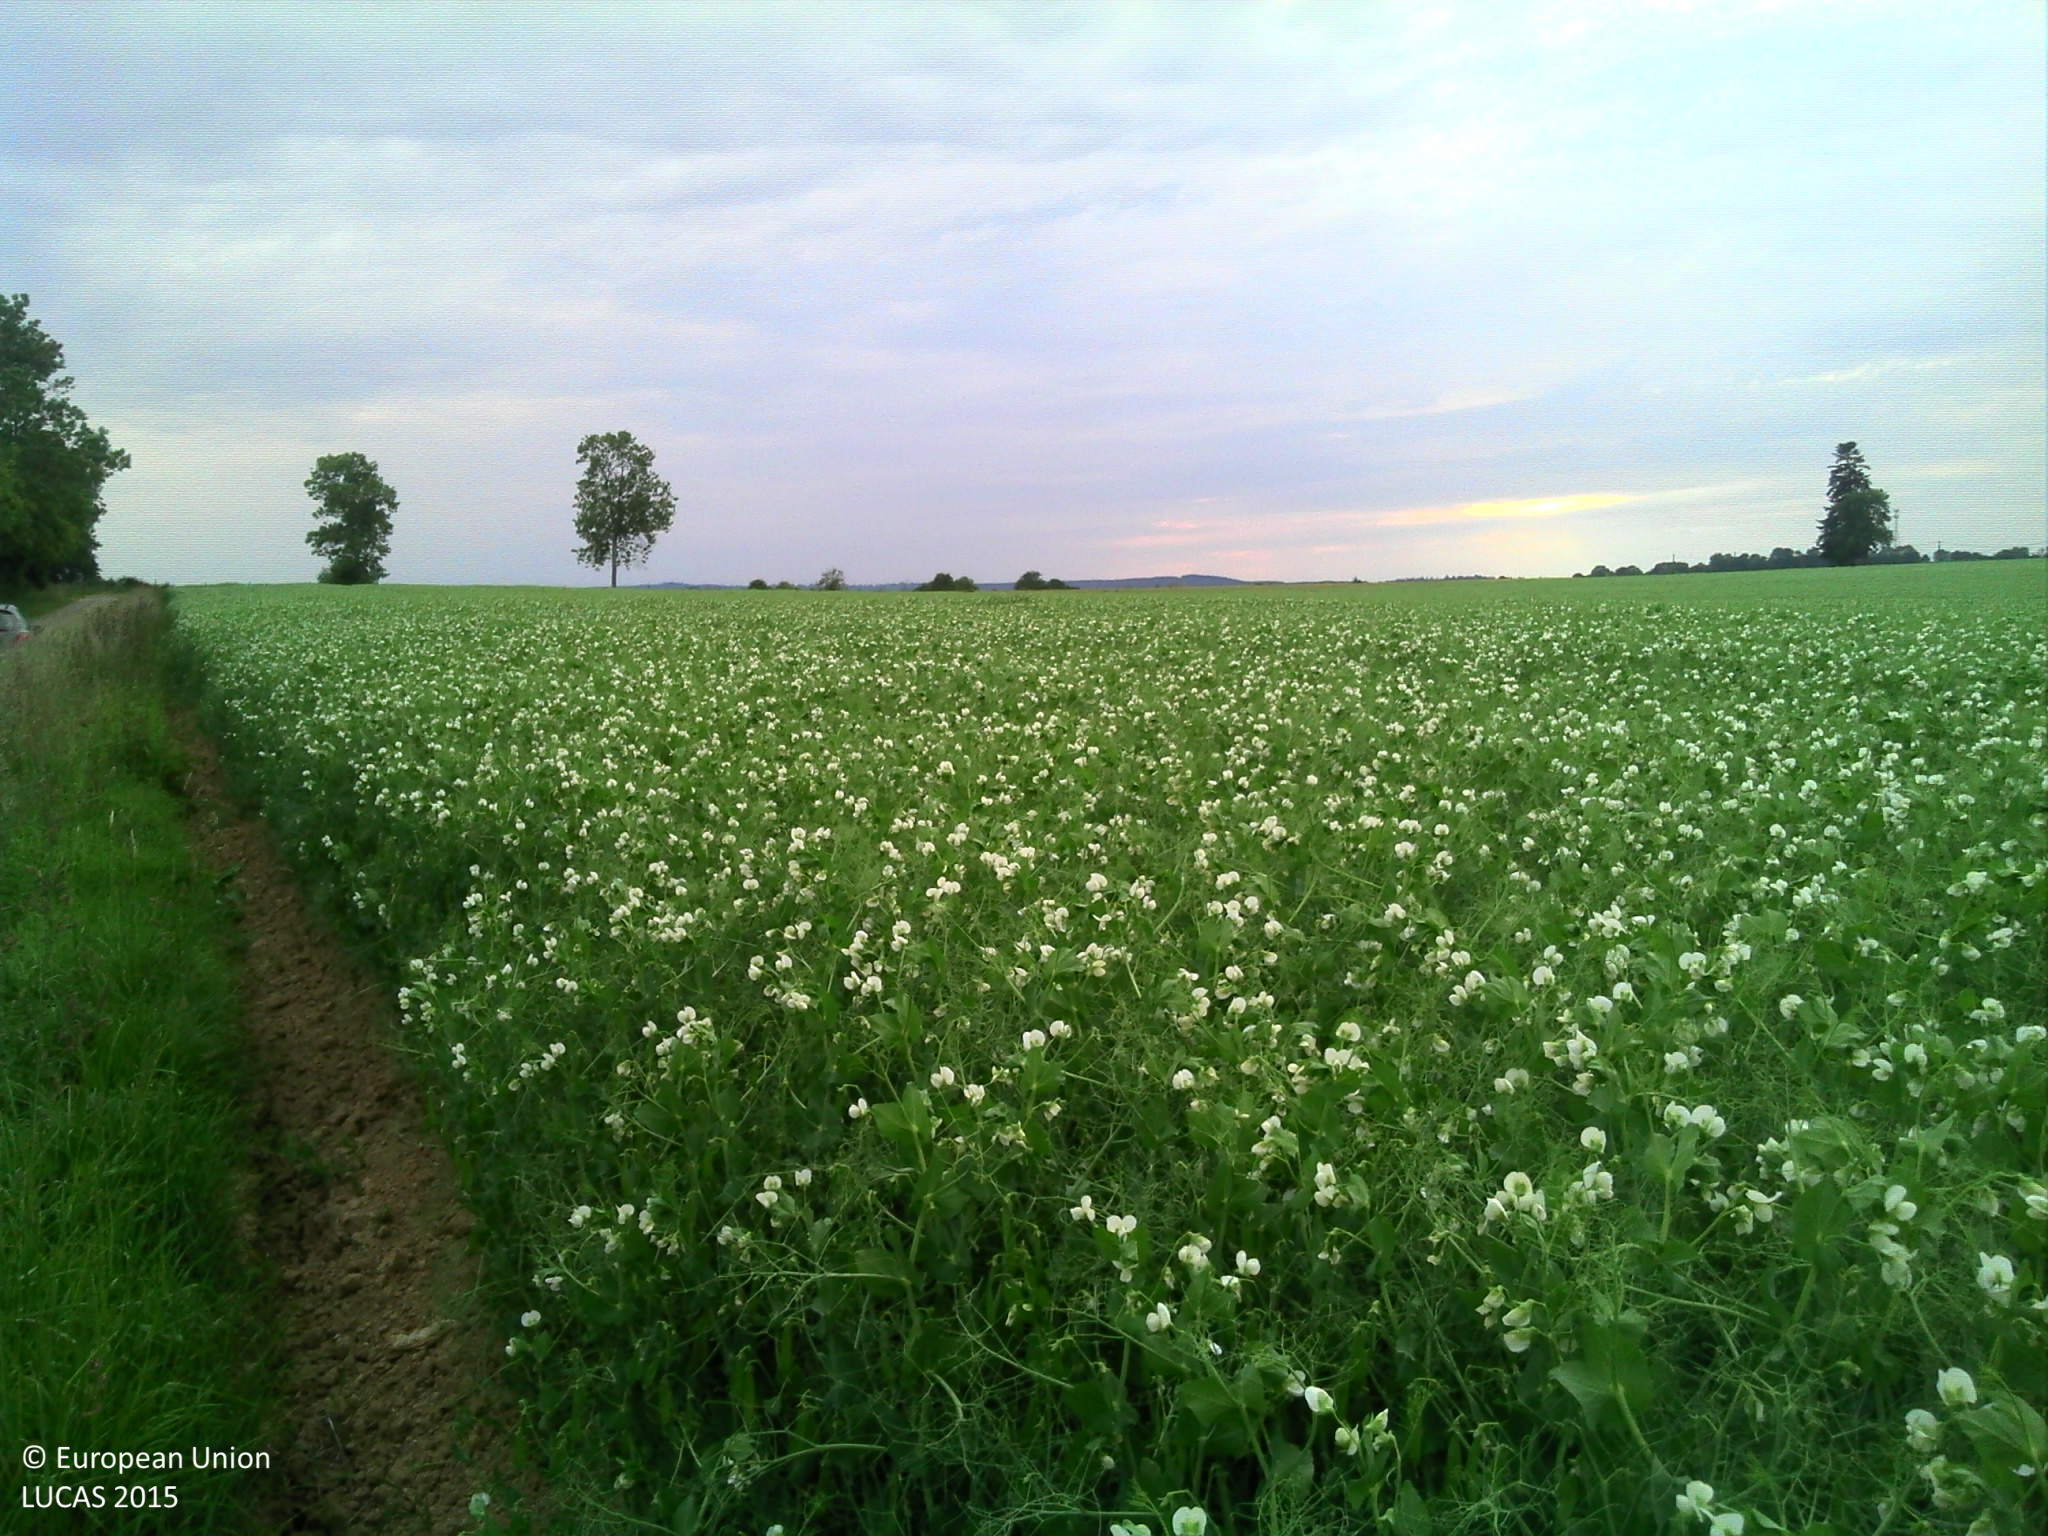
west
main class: Cropland
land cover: Dry pulses
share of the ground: > 75 %
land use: Agriculture (excluding fallow land and kitchen gardens)
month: June
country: FR
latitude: 48.5654
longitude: 0.2019
